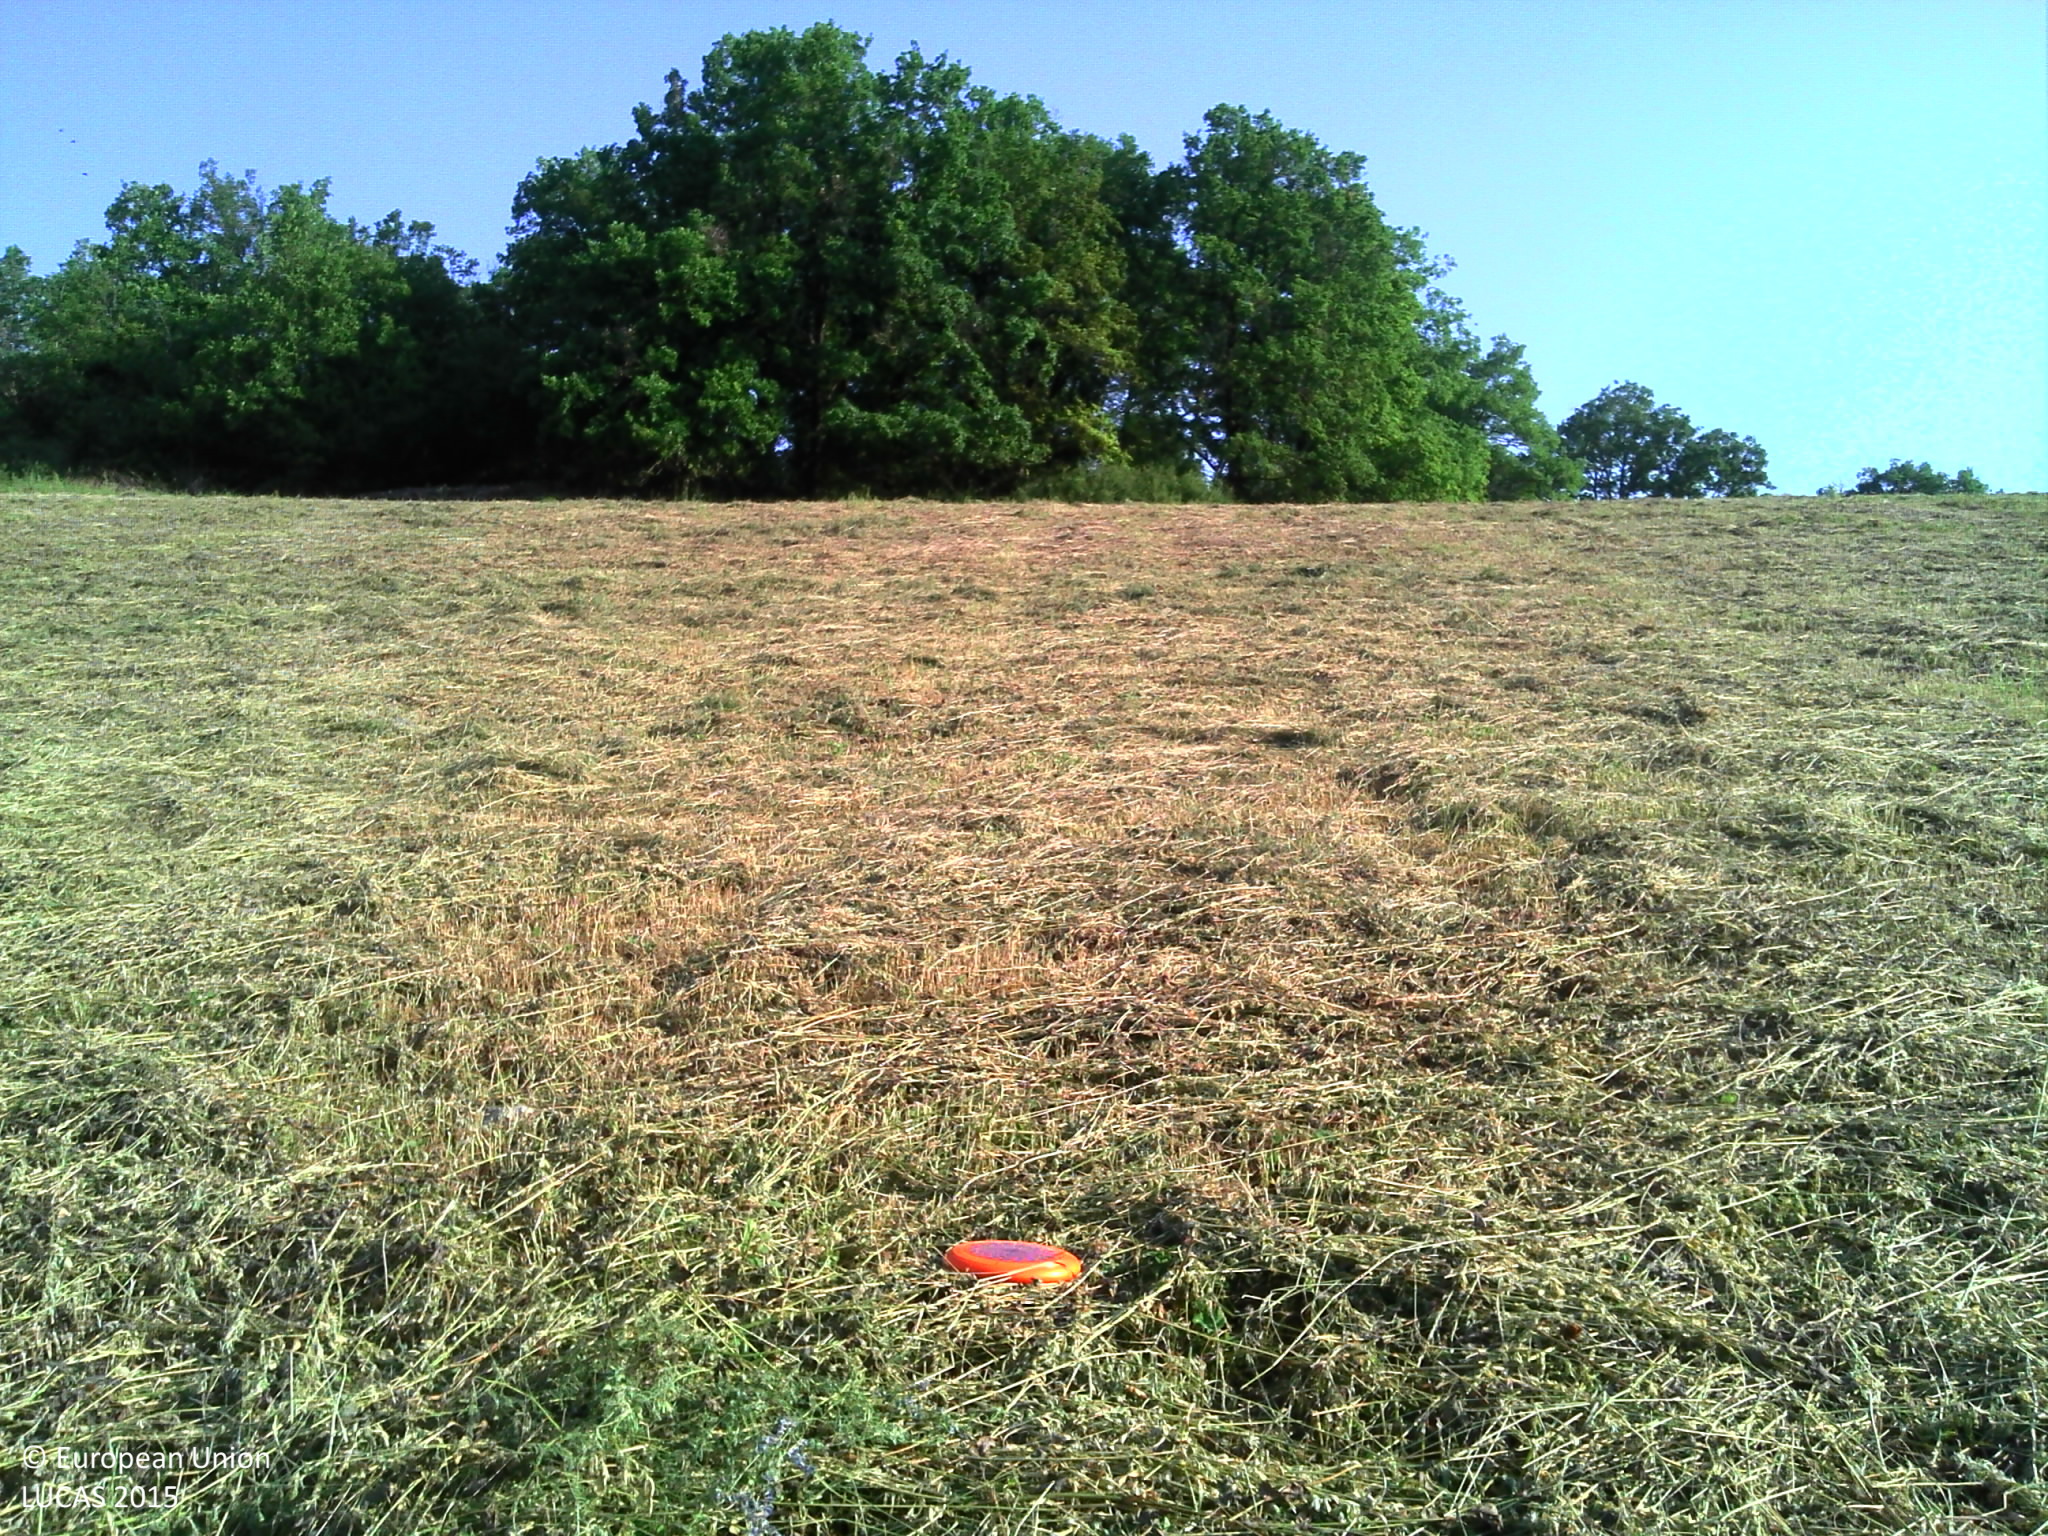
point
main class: Cropland
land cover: Other leguminous and mixtures for fodder
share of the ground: > 75 %
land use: Agriculture (excluding fallow land and kitchen gardens)
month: June
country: FR
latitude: 47.6553
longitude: 3.8591
